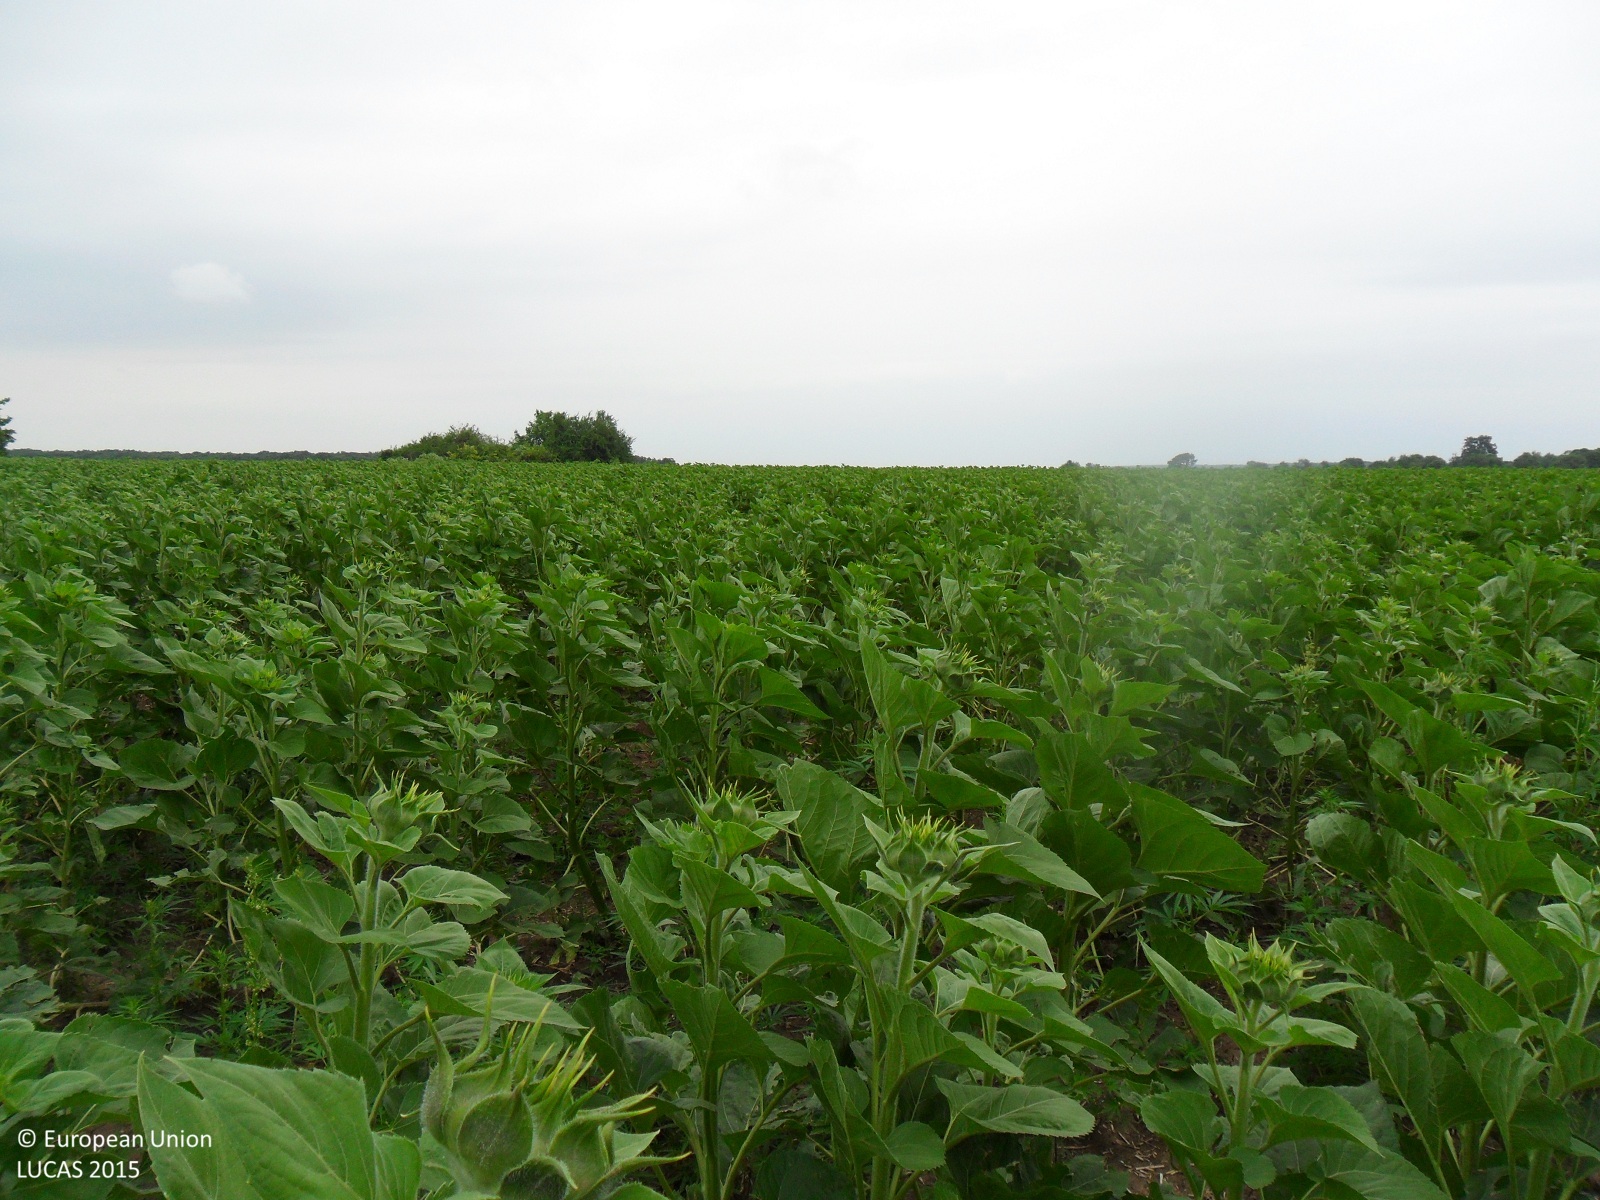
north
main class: Cropland
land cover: Sunflower
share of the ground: > 75 %
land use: Agriculture (excluding fallow land and kitchen gardens)
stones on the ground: < 10 %
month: June
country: BG
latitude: 43.8130
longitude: 26.8122
